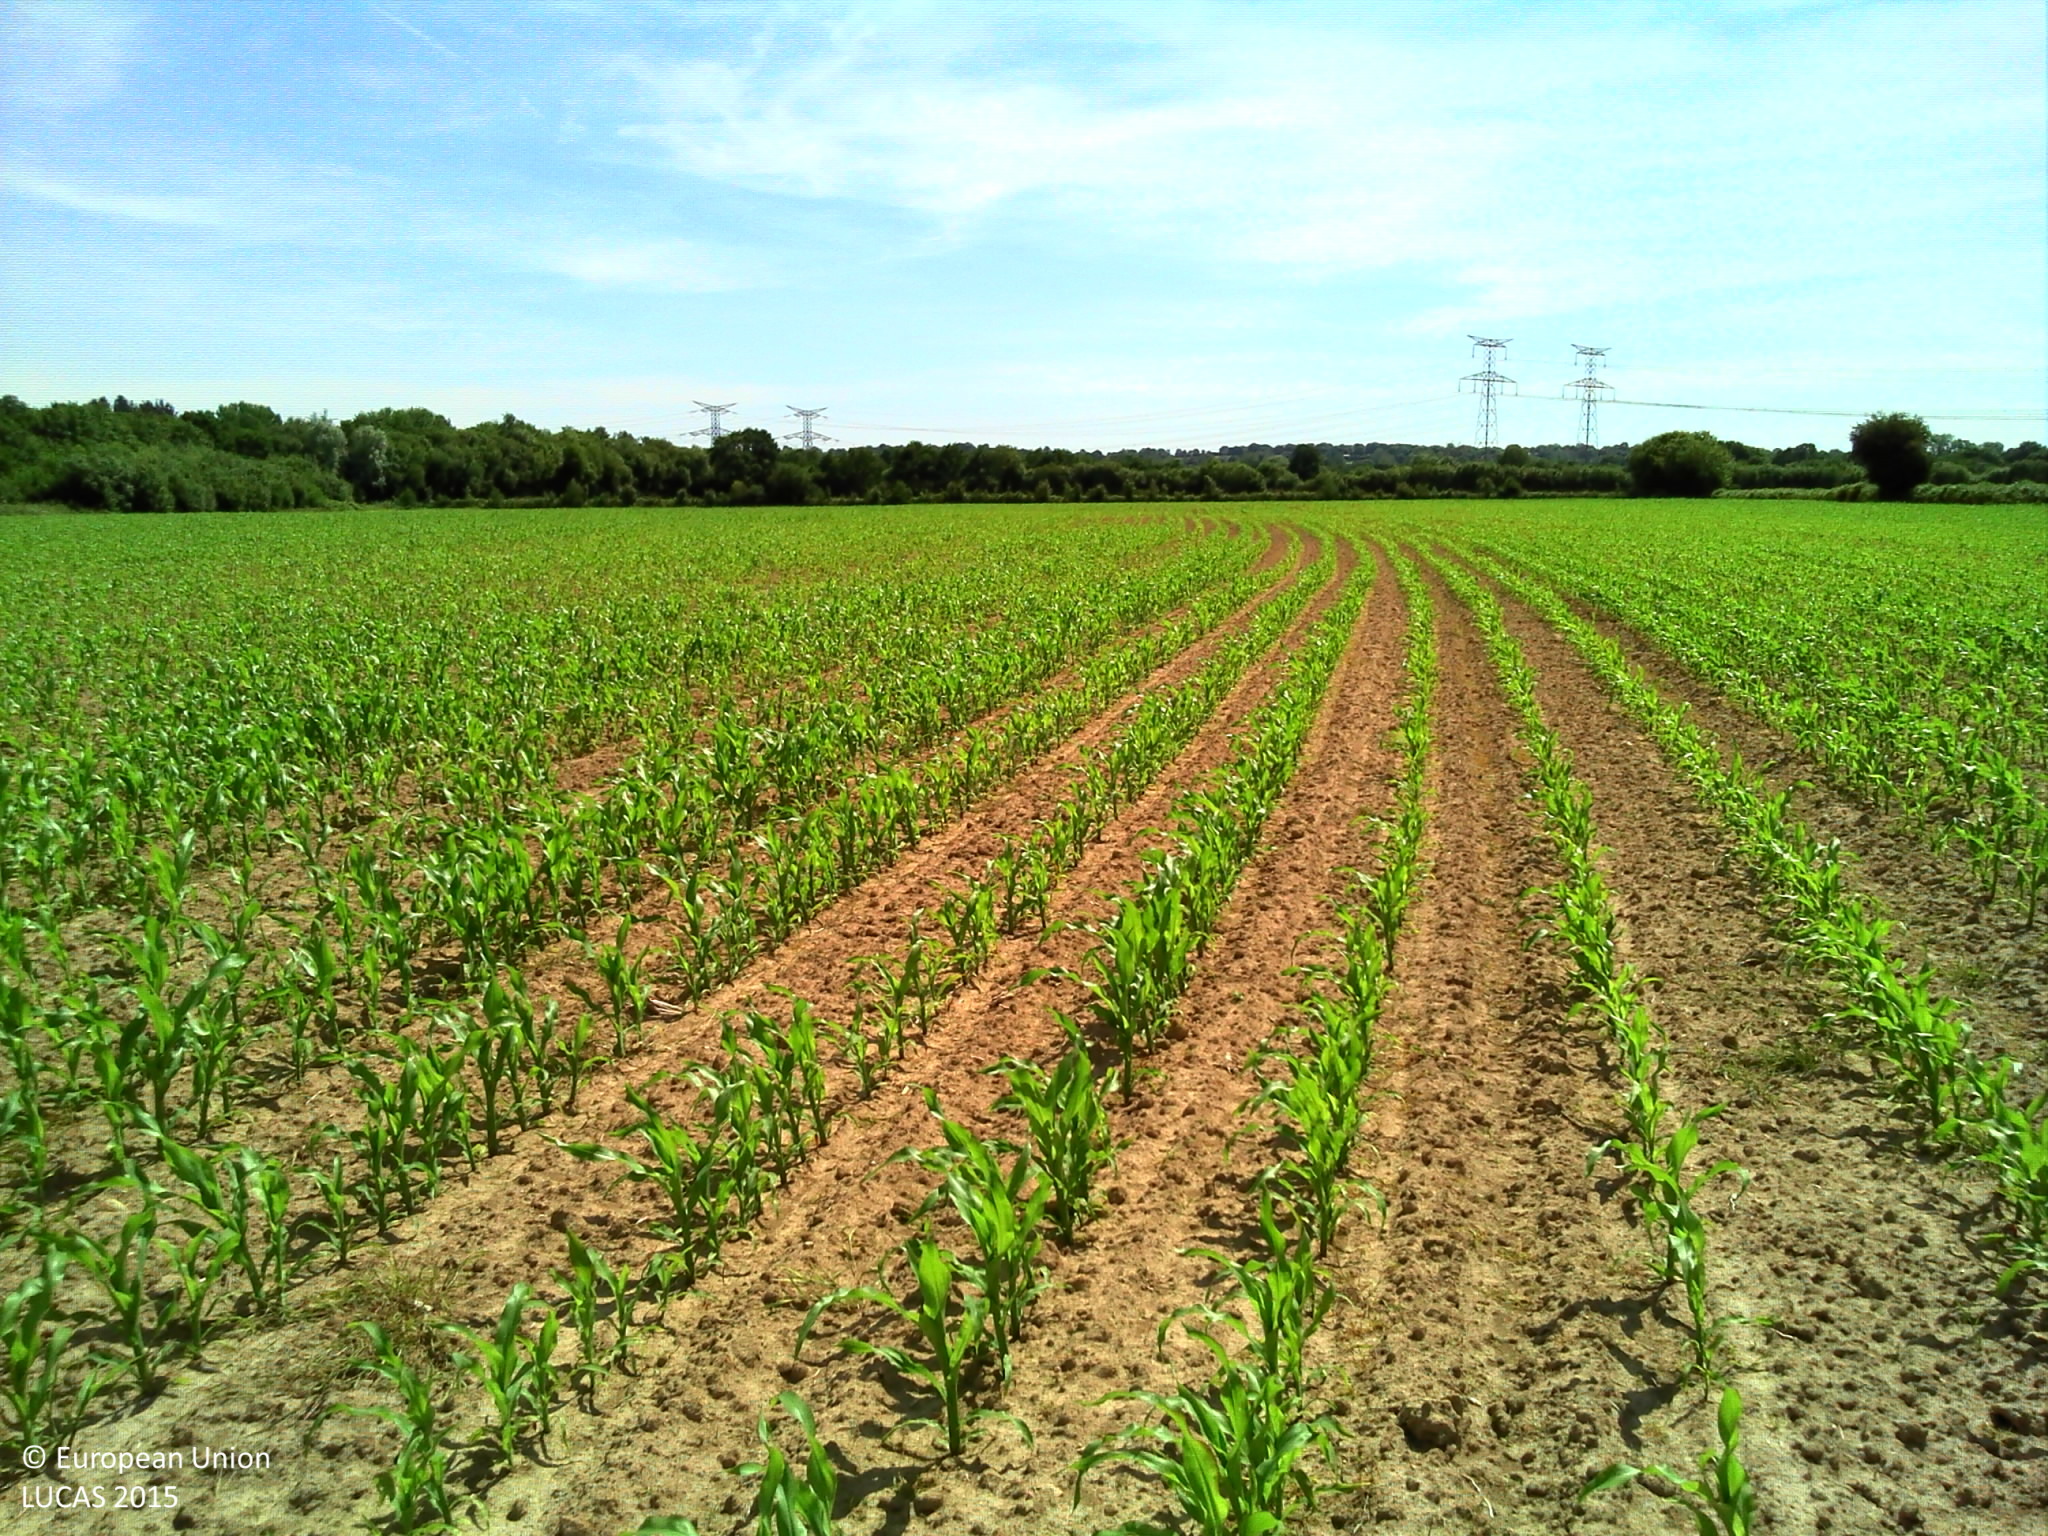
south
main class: Cropland
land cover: Maize
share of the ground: 25 - 50 %
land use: Agriculture (excluding fallow land and kitchen gardens)
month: June
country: FR
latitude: 49.1808
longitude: -1.3371
